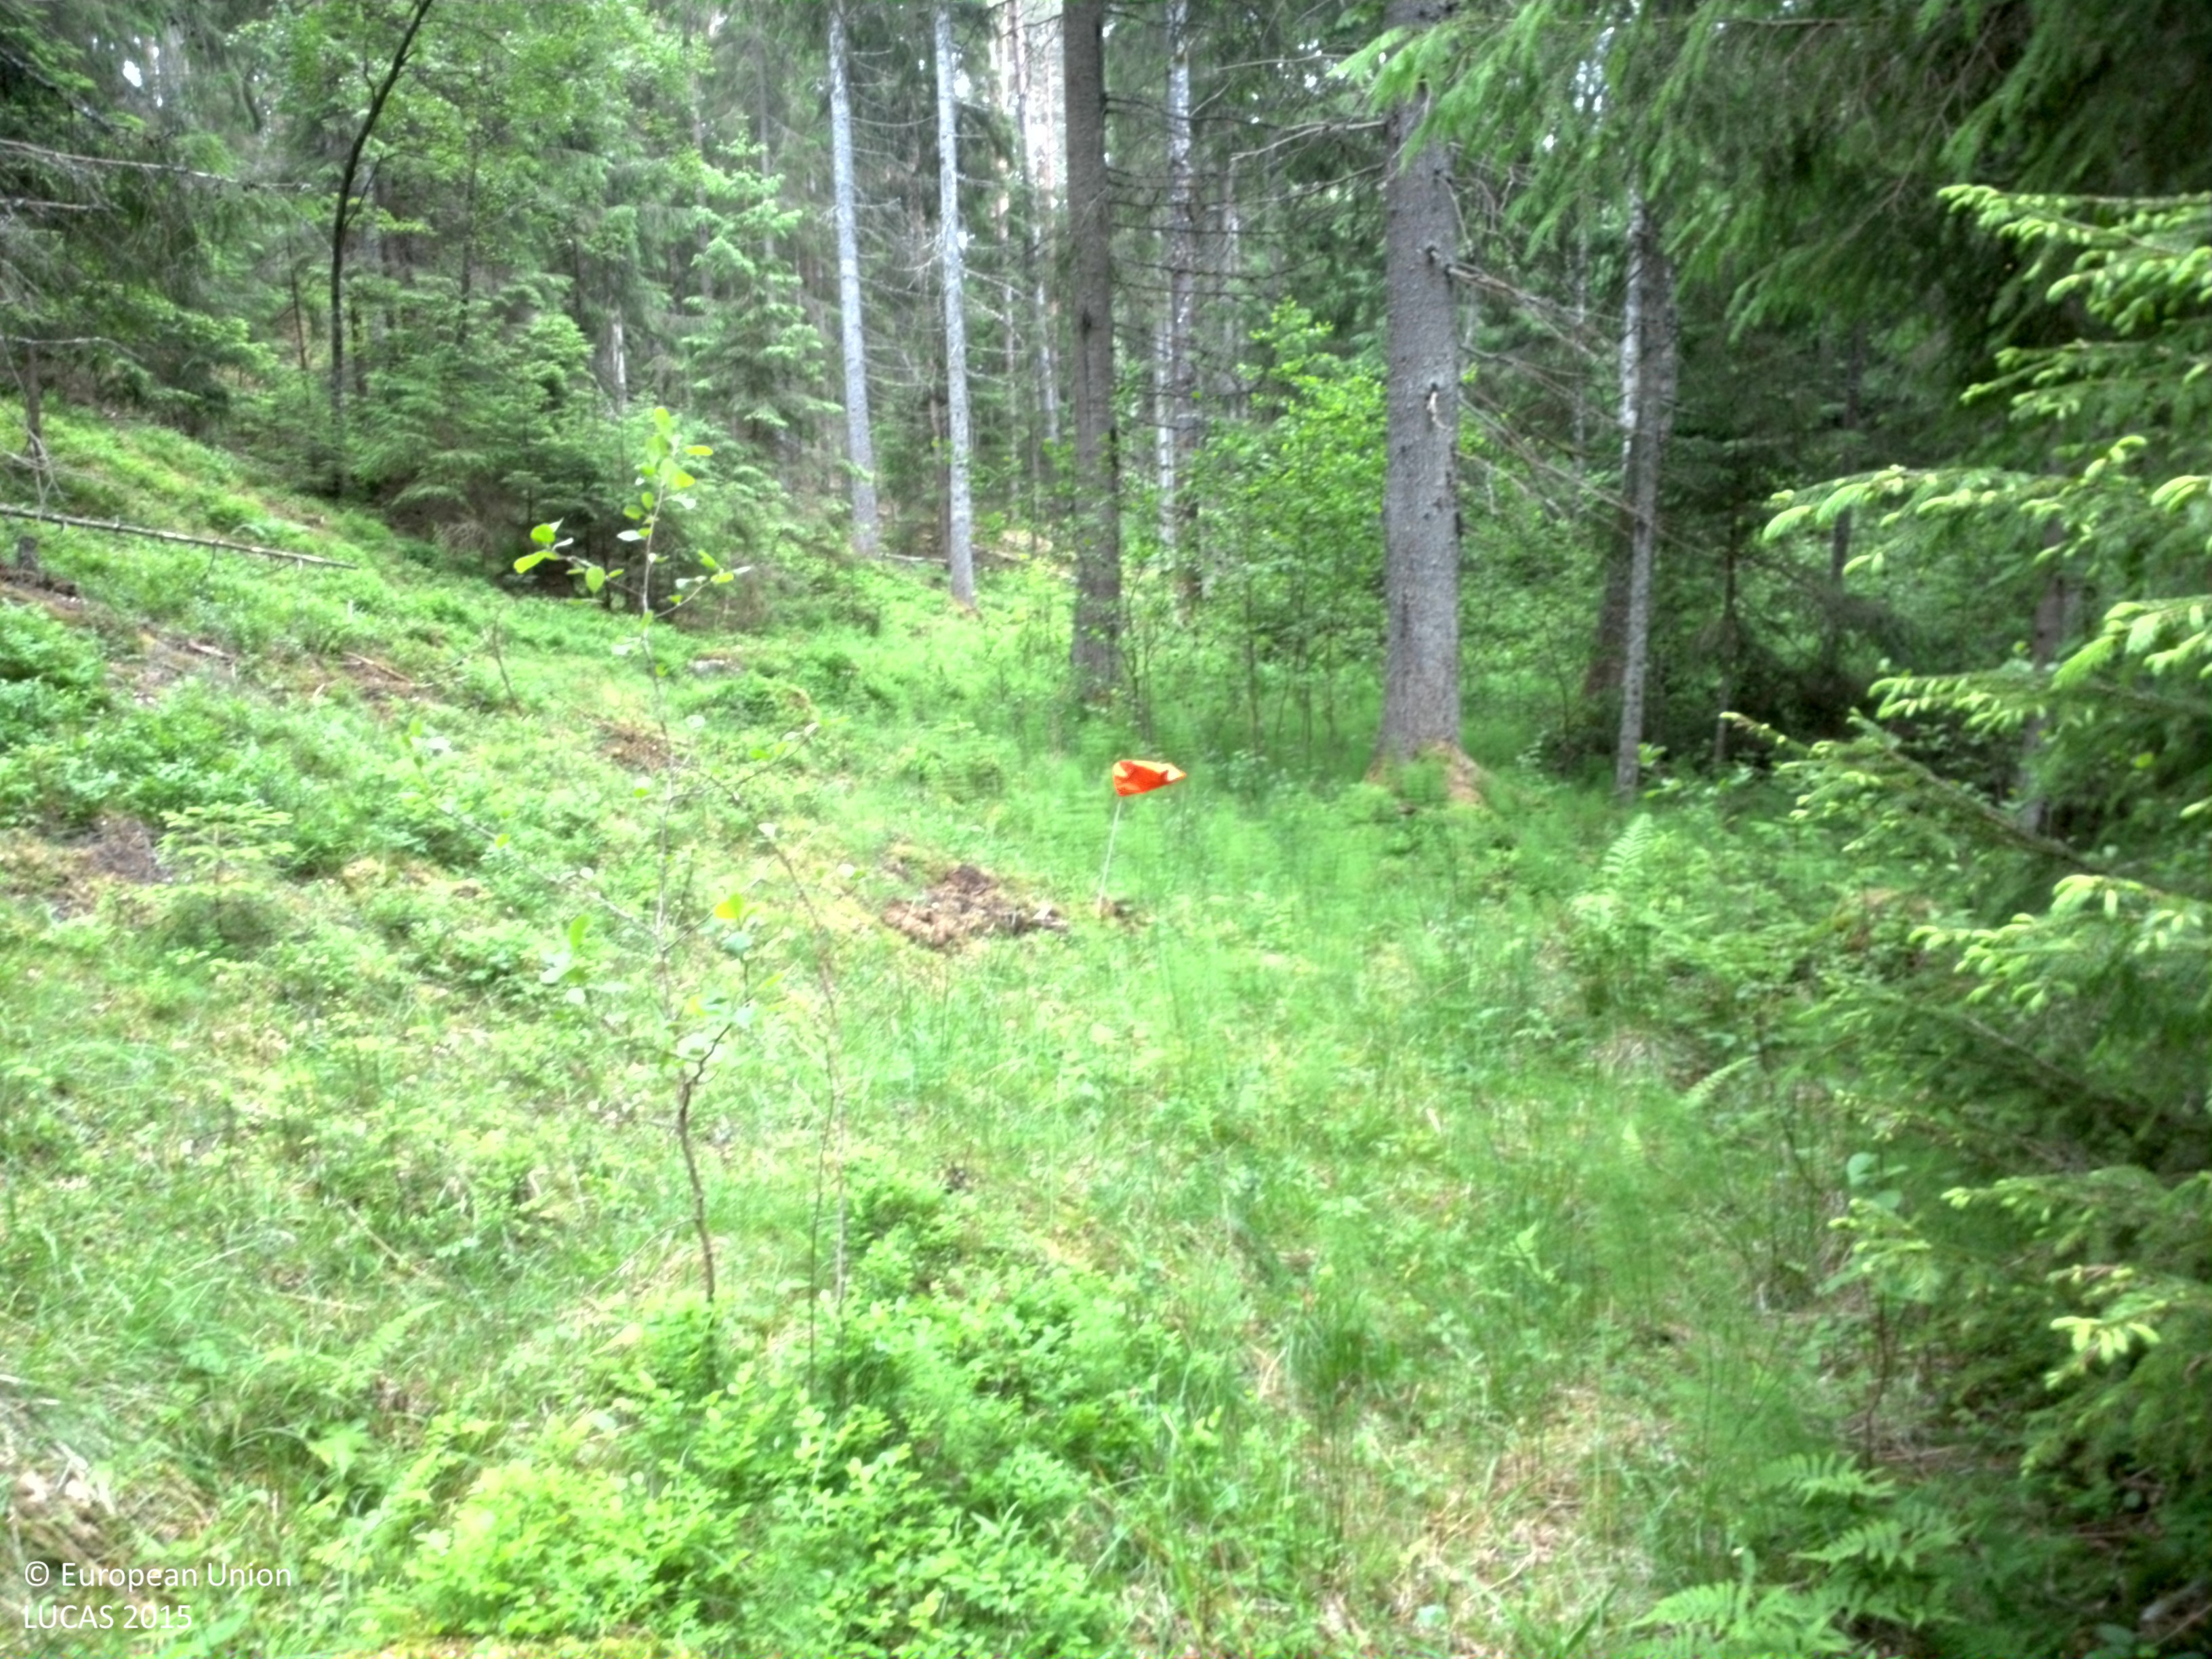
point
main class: Woodland
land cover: Spruce dominated coniferous woodland
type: boreal forest
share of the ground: 25 - 50 %
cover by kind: herbaceous plants 55 %, coniferous forest trees 30 %, lichens and mosses 10 %, broadleaved forest trees 5 %
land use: Forestry
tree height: > 5 m
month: June
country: SE
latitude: 58.6980
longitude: 15.6021
